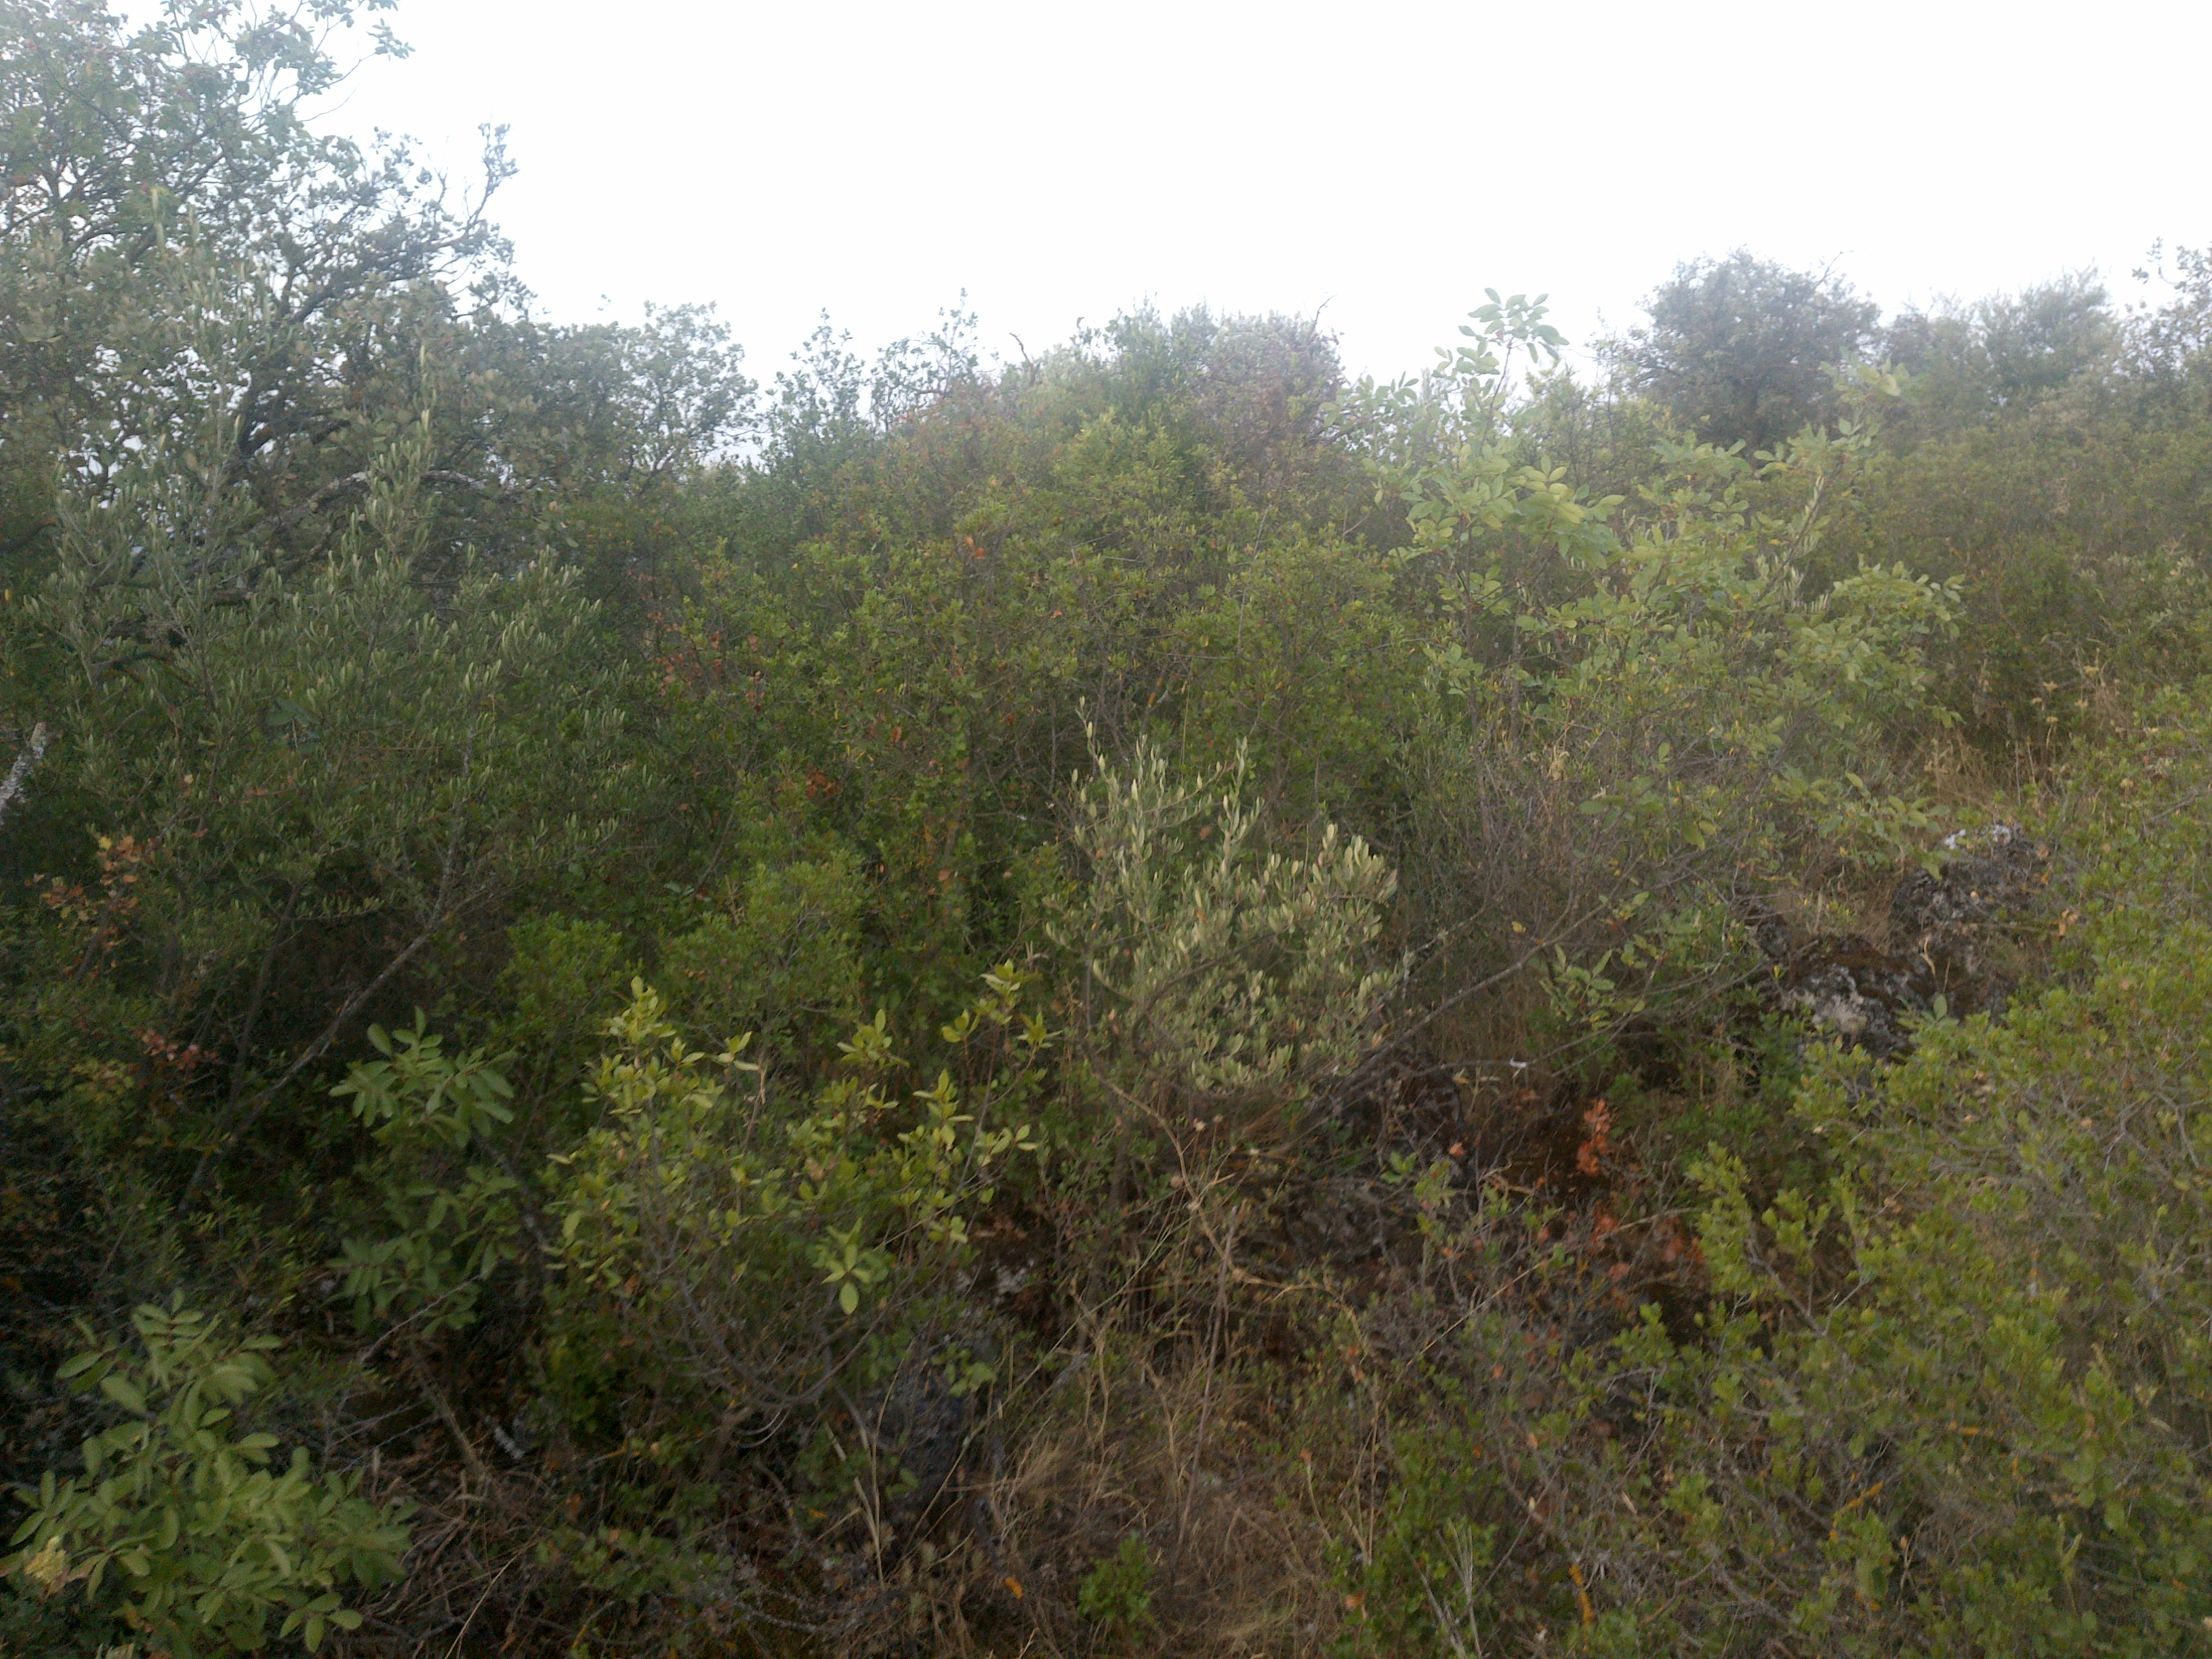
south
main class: Shrubland
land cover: Shrubland with sparse tree cover
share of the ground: 50 - 75 %
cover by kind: shrubs 50 %, unconsolidated bare surface 30 %, herbaceous plants 15 %, broadleaved forest trees 5 %
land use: Semi-natural and natural areas not in use
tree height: < 5 m
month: July
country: ES
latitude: 37.4875
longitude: -4.4230
